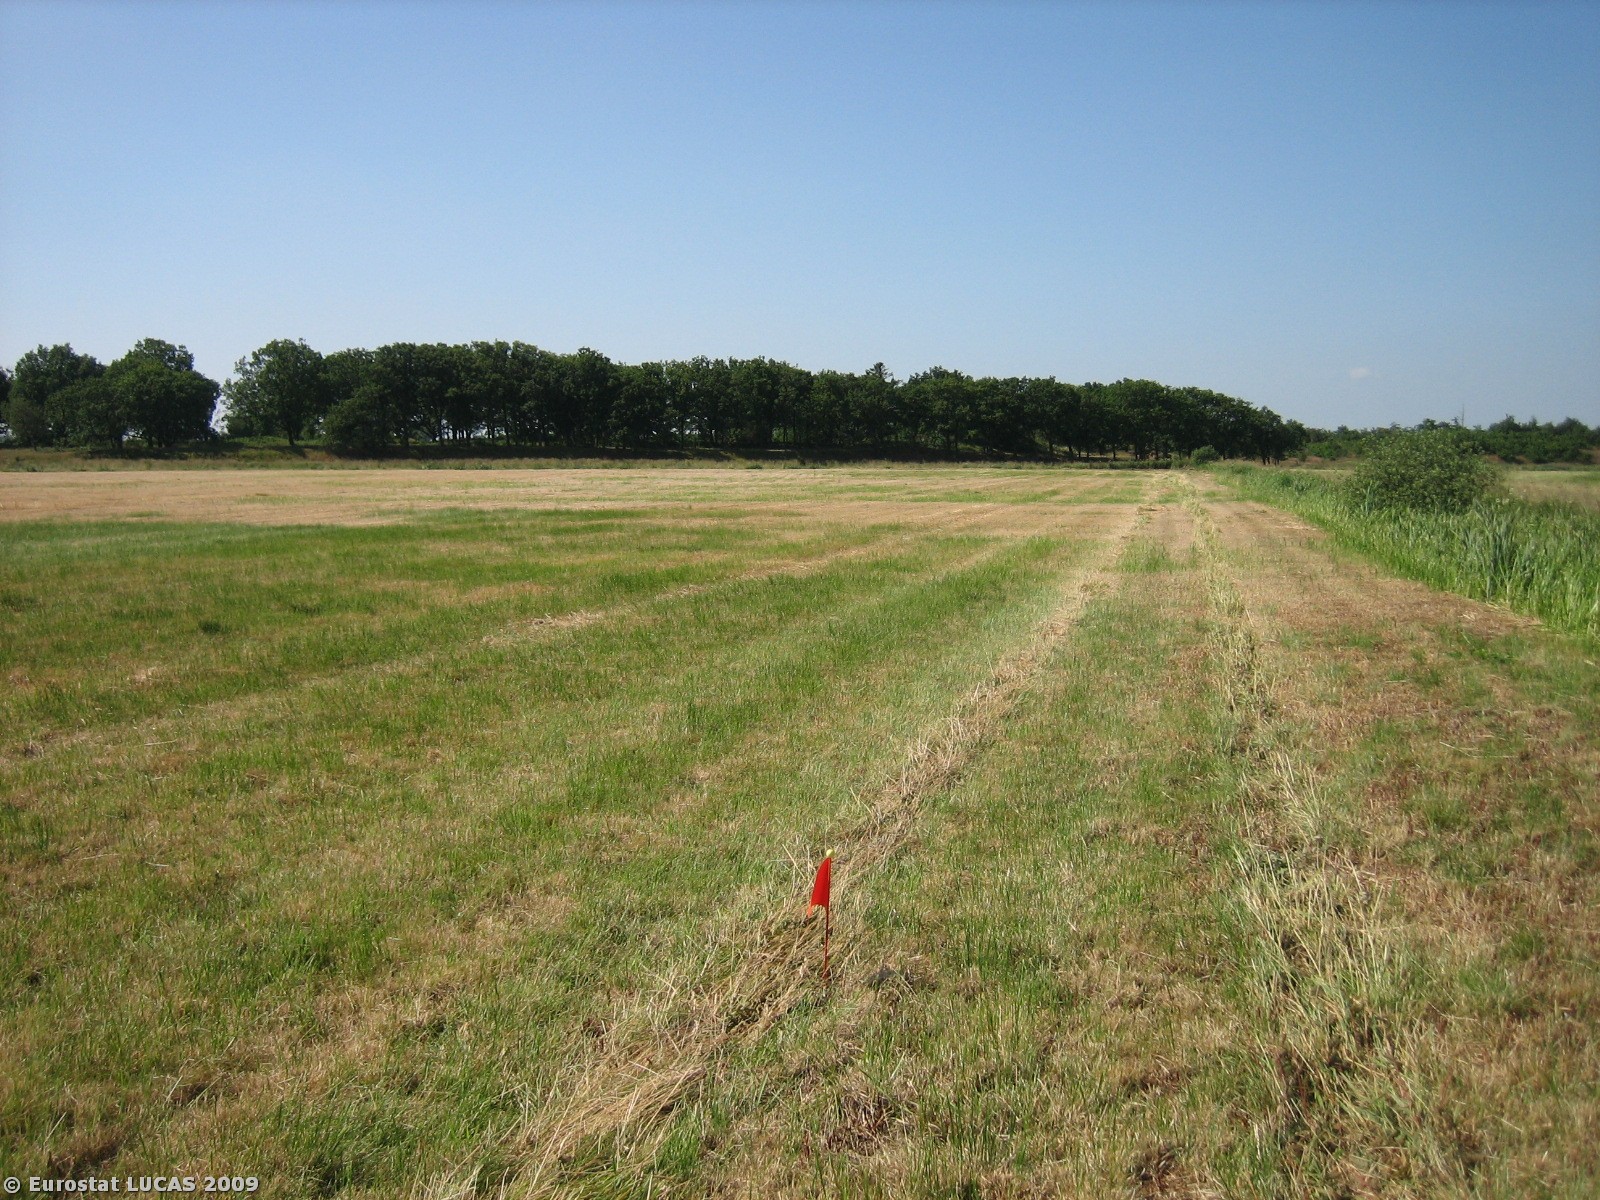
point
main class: Cropland
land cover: Temporary grasslands
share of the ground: > 75 %
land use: Agriculture (excluding fallow land and kitchen gardens)
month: July
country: DK
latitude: 55.4099
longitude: 8.8796
